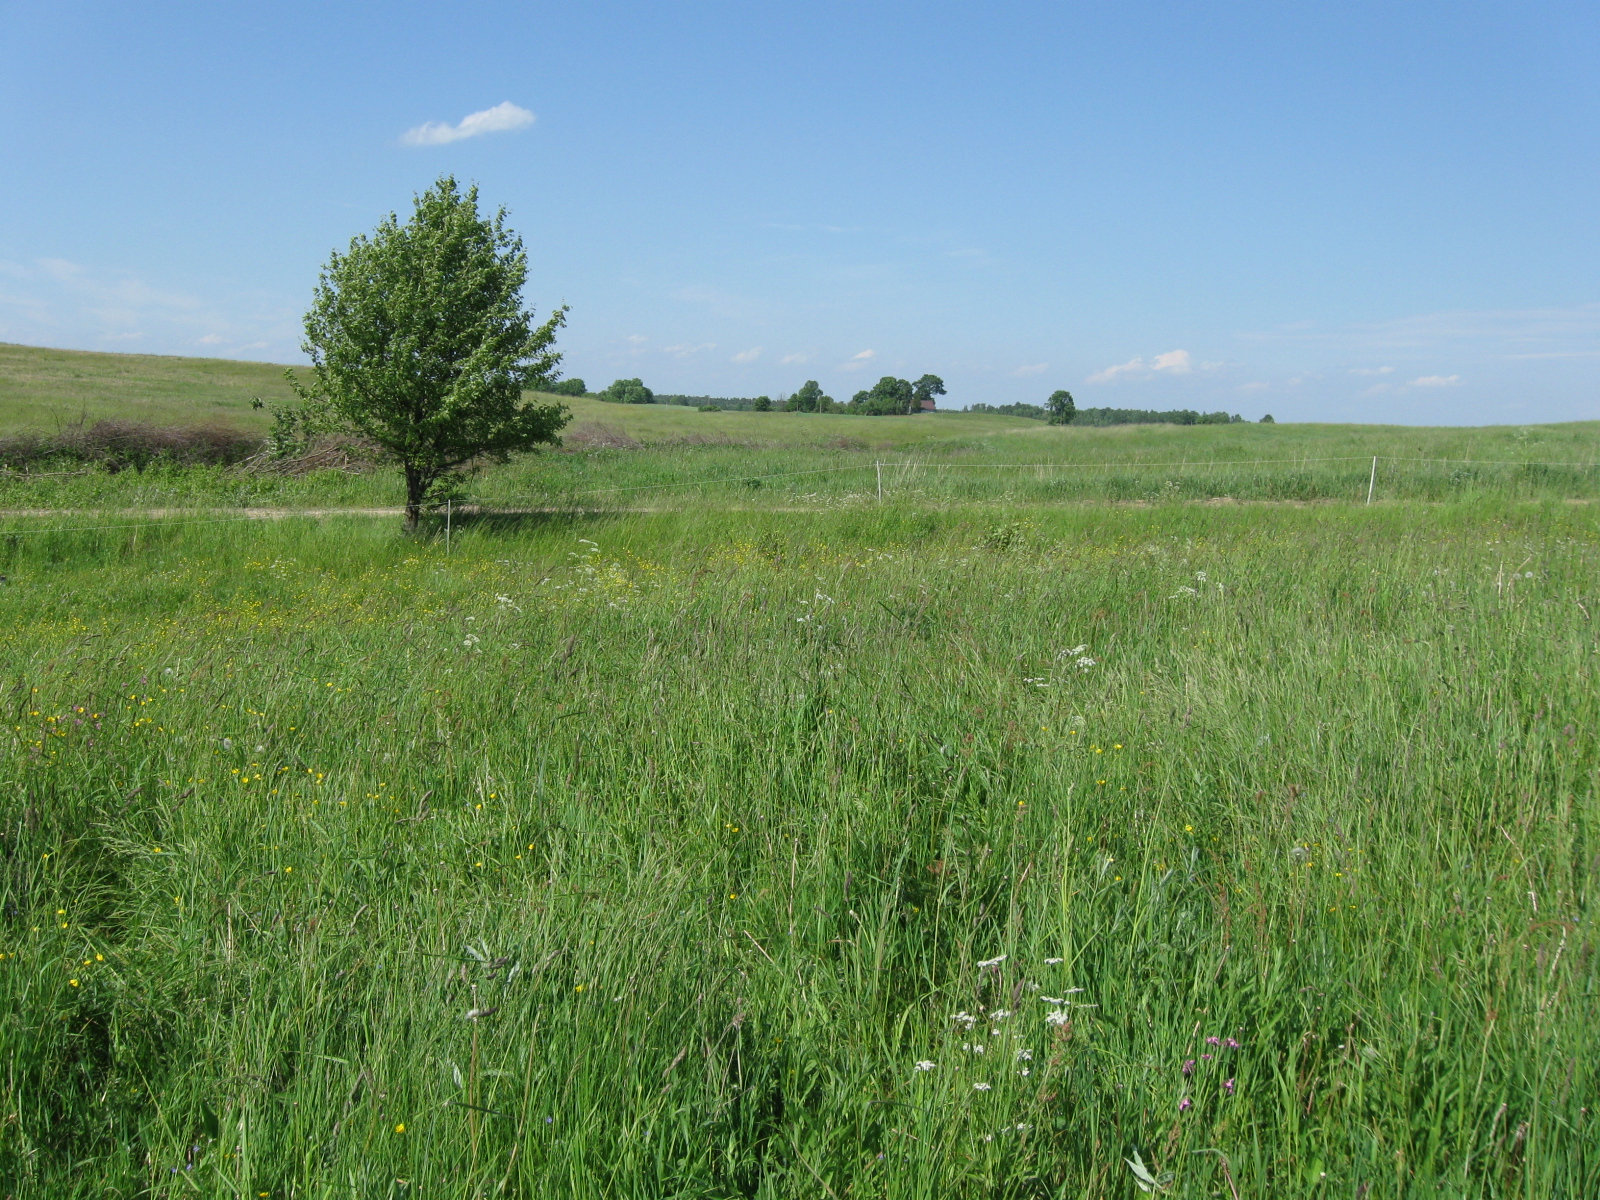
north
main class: Grassland
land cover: Grassland without tree/shrub cover
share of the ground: > 75 %
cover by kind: herbaceous plants 100 %
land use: Agriculture (excluding fallow land and kitchen gardens)
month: June
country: LT
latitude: 54.2540
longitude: 23.7639
